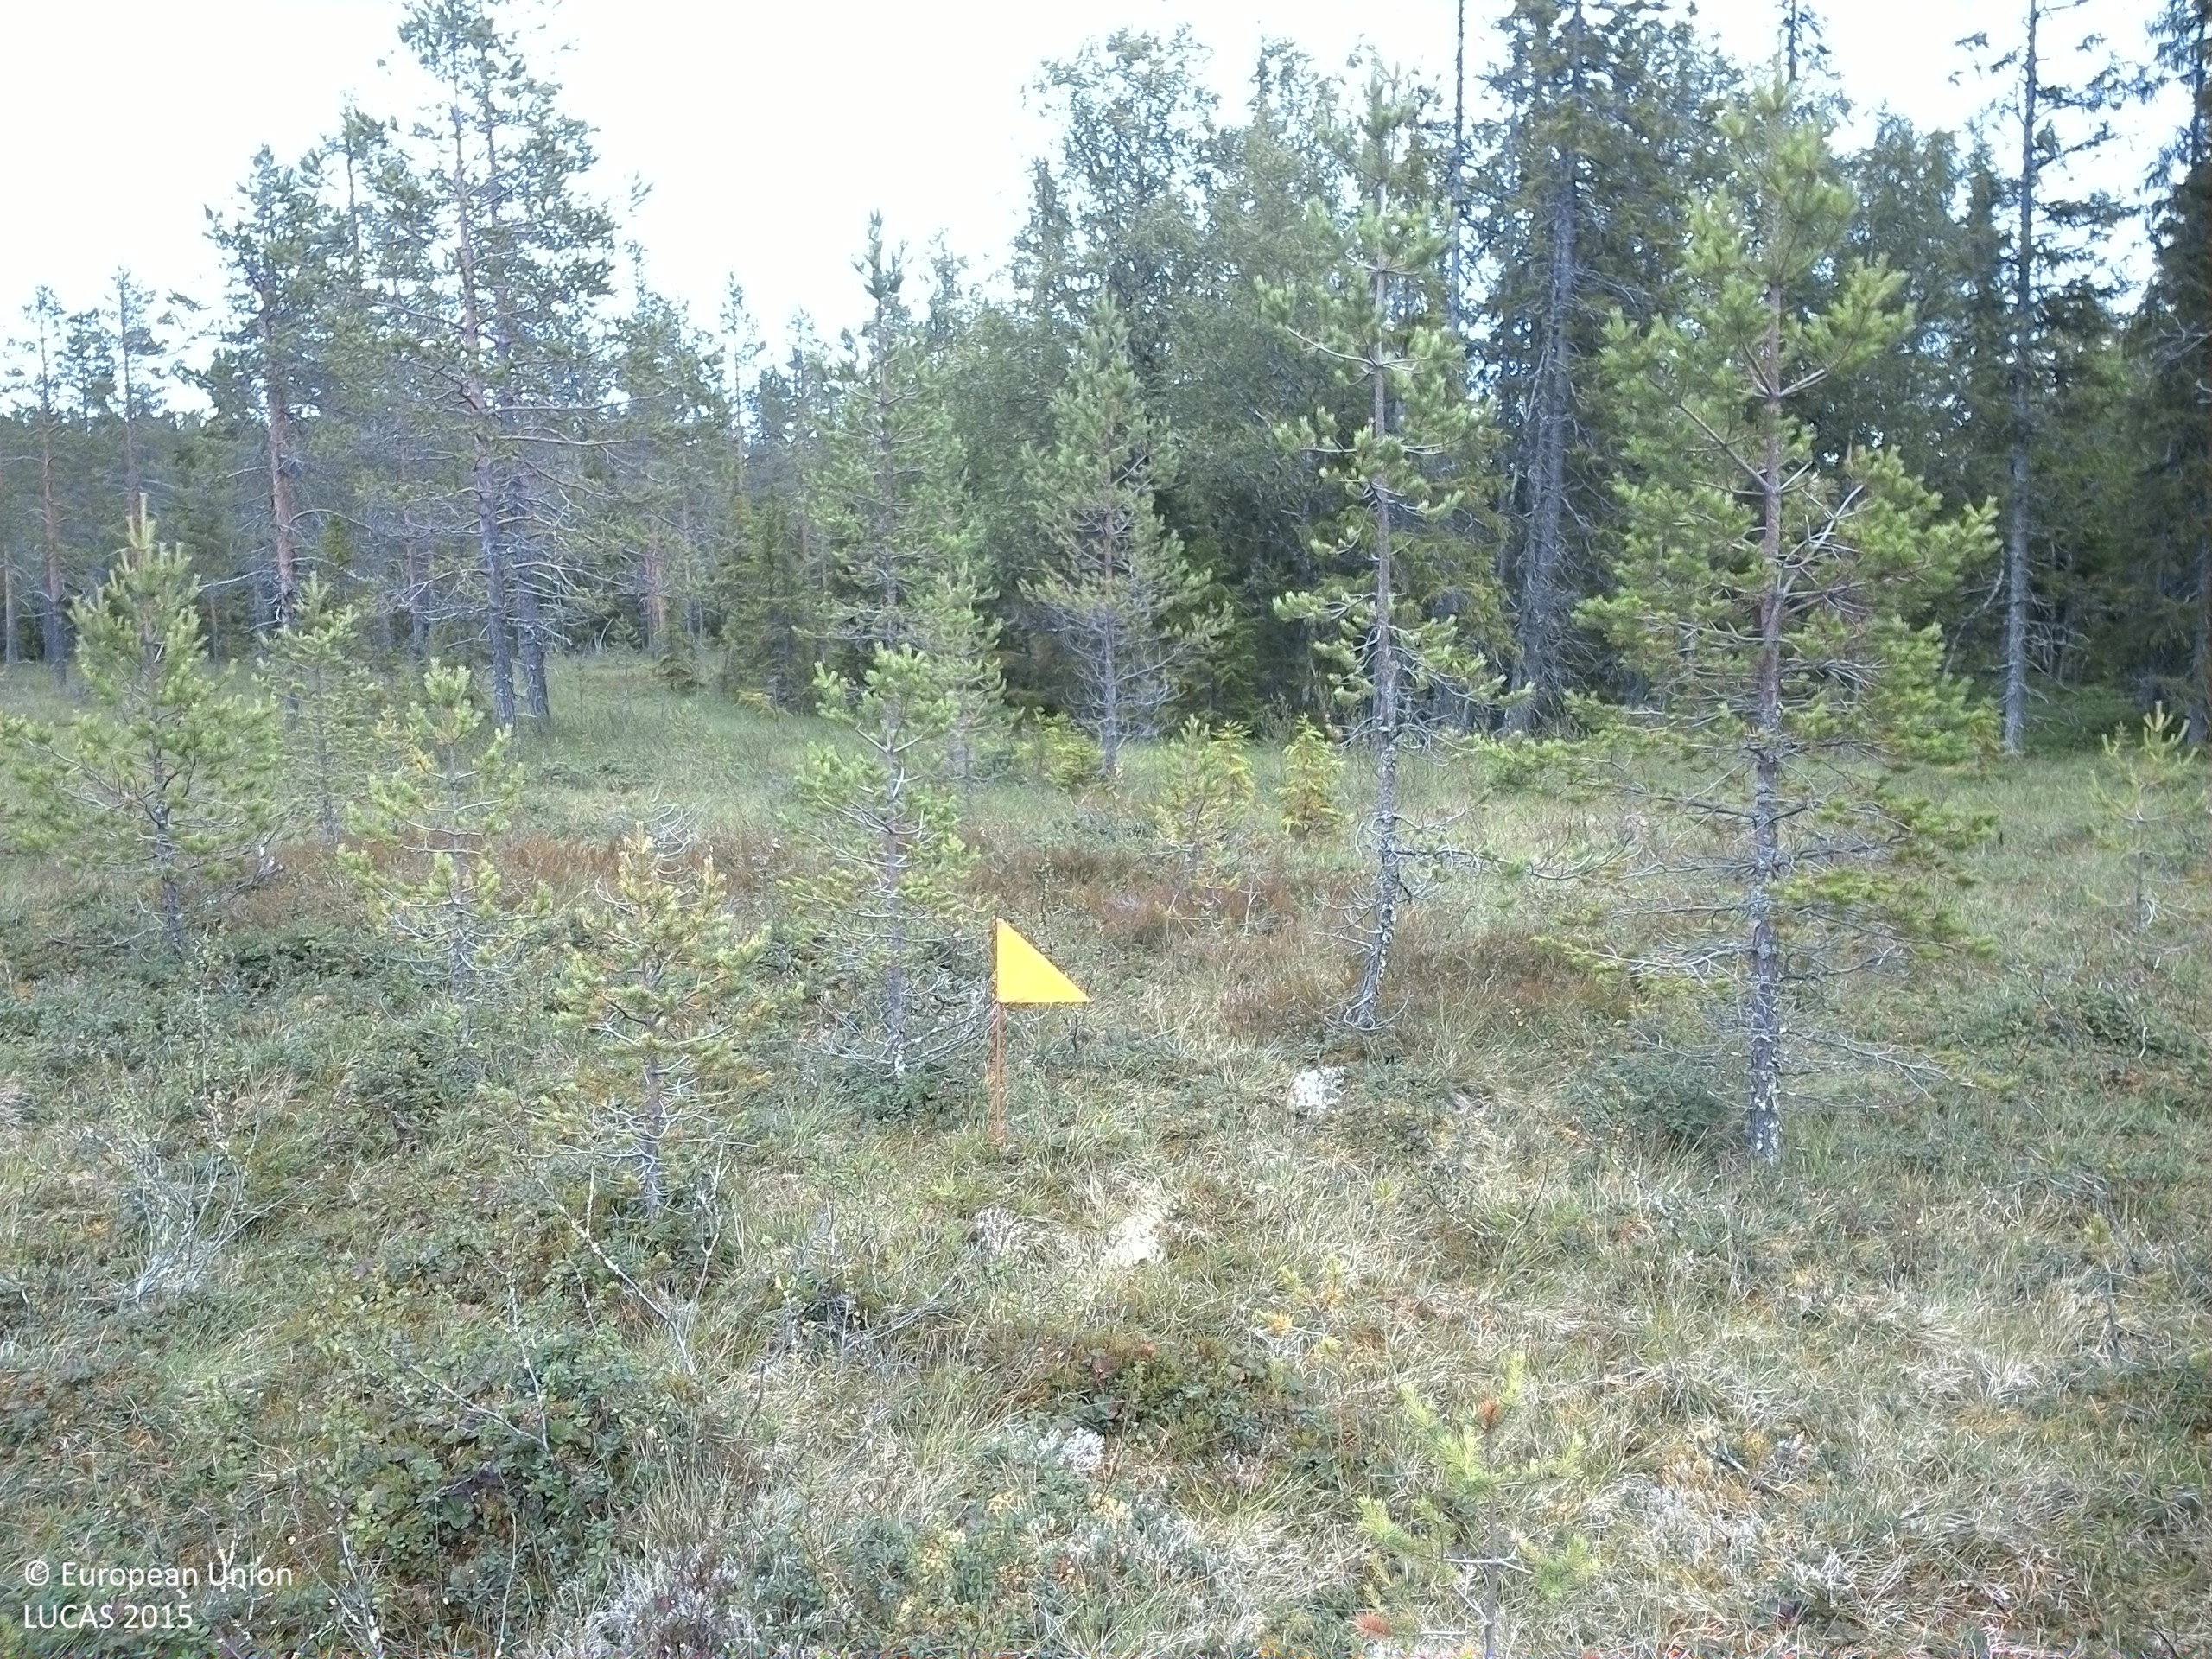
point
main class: Woodland
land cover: Pine dominated coniferous woodland
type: boreal forest
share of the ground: 10 - 25 %
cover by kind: lichens and mosses 40 %, shrubs 35 %, coniferous forest trees 15 %, herbaceous plants 10 %
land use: Forestry
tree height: < 5 m
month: August
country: SE
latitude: 62.8752
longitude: 17.1927
